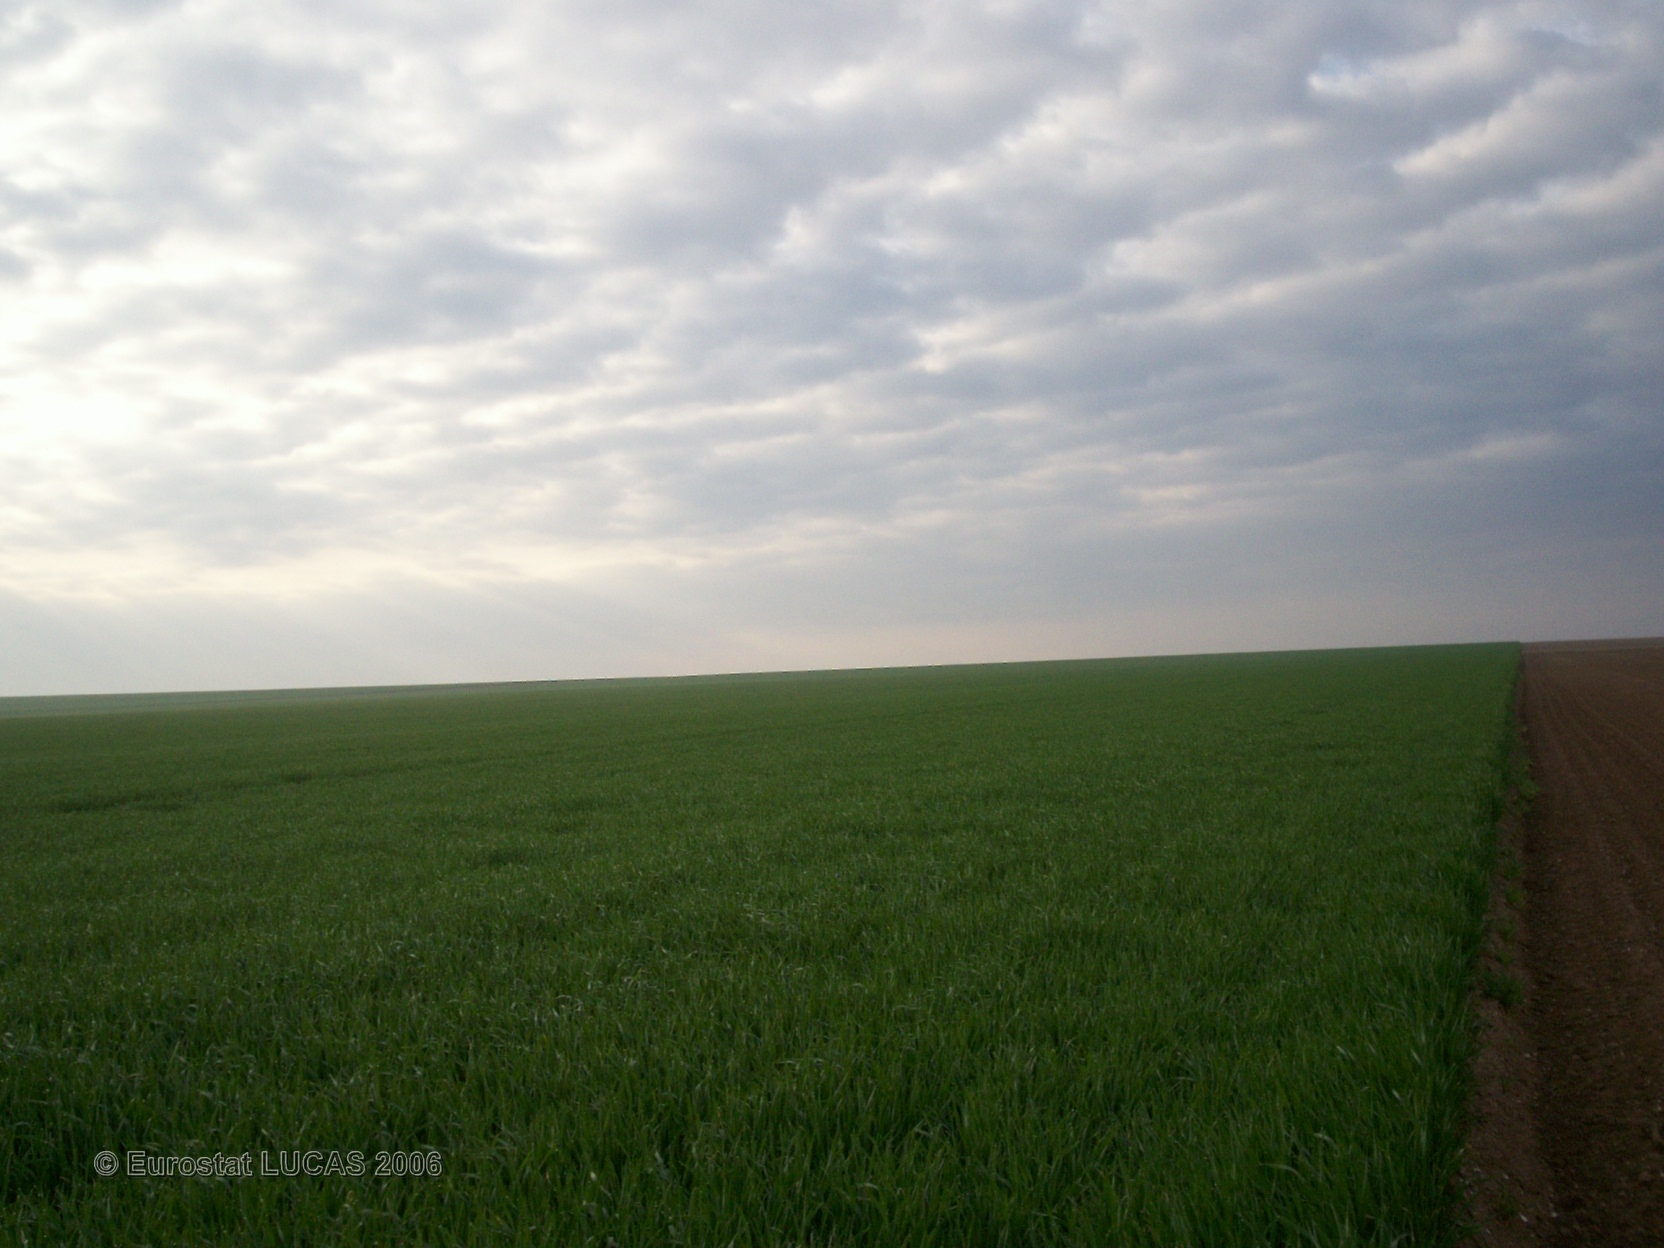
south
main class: Cropland
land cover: Dry pulses
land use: Agriculture (excluding fallow land and kitchen gardens)
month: April
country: FR
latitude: 48.7247
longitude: 3.9460
